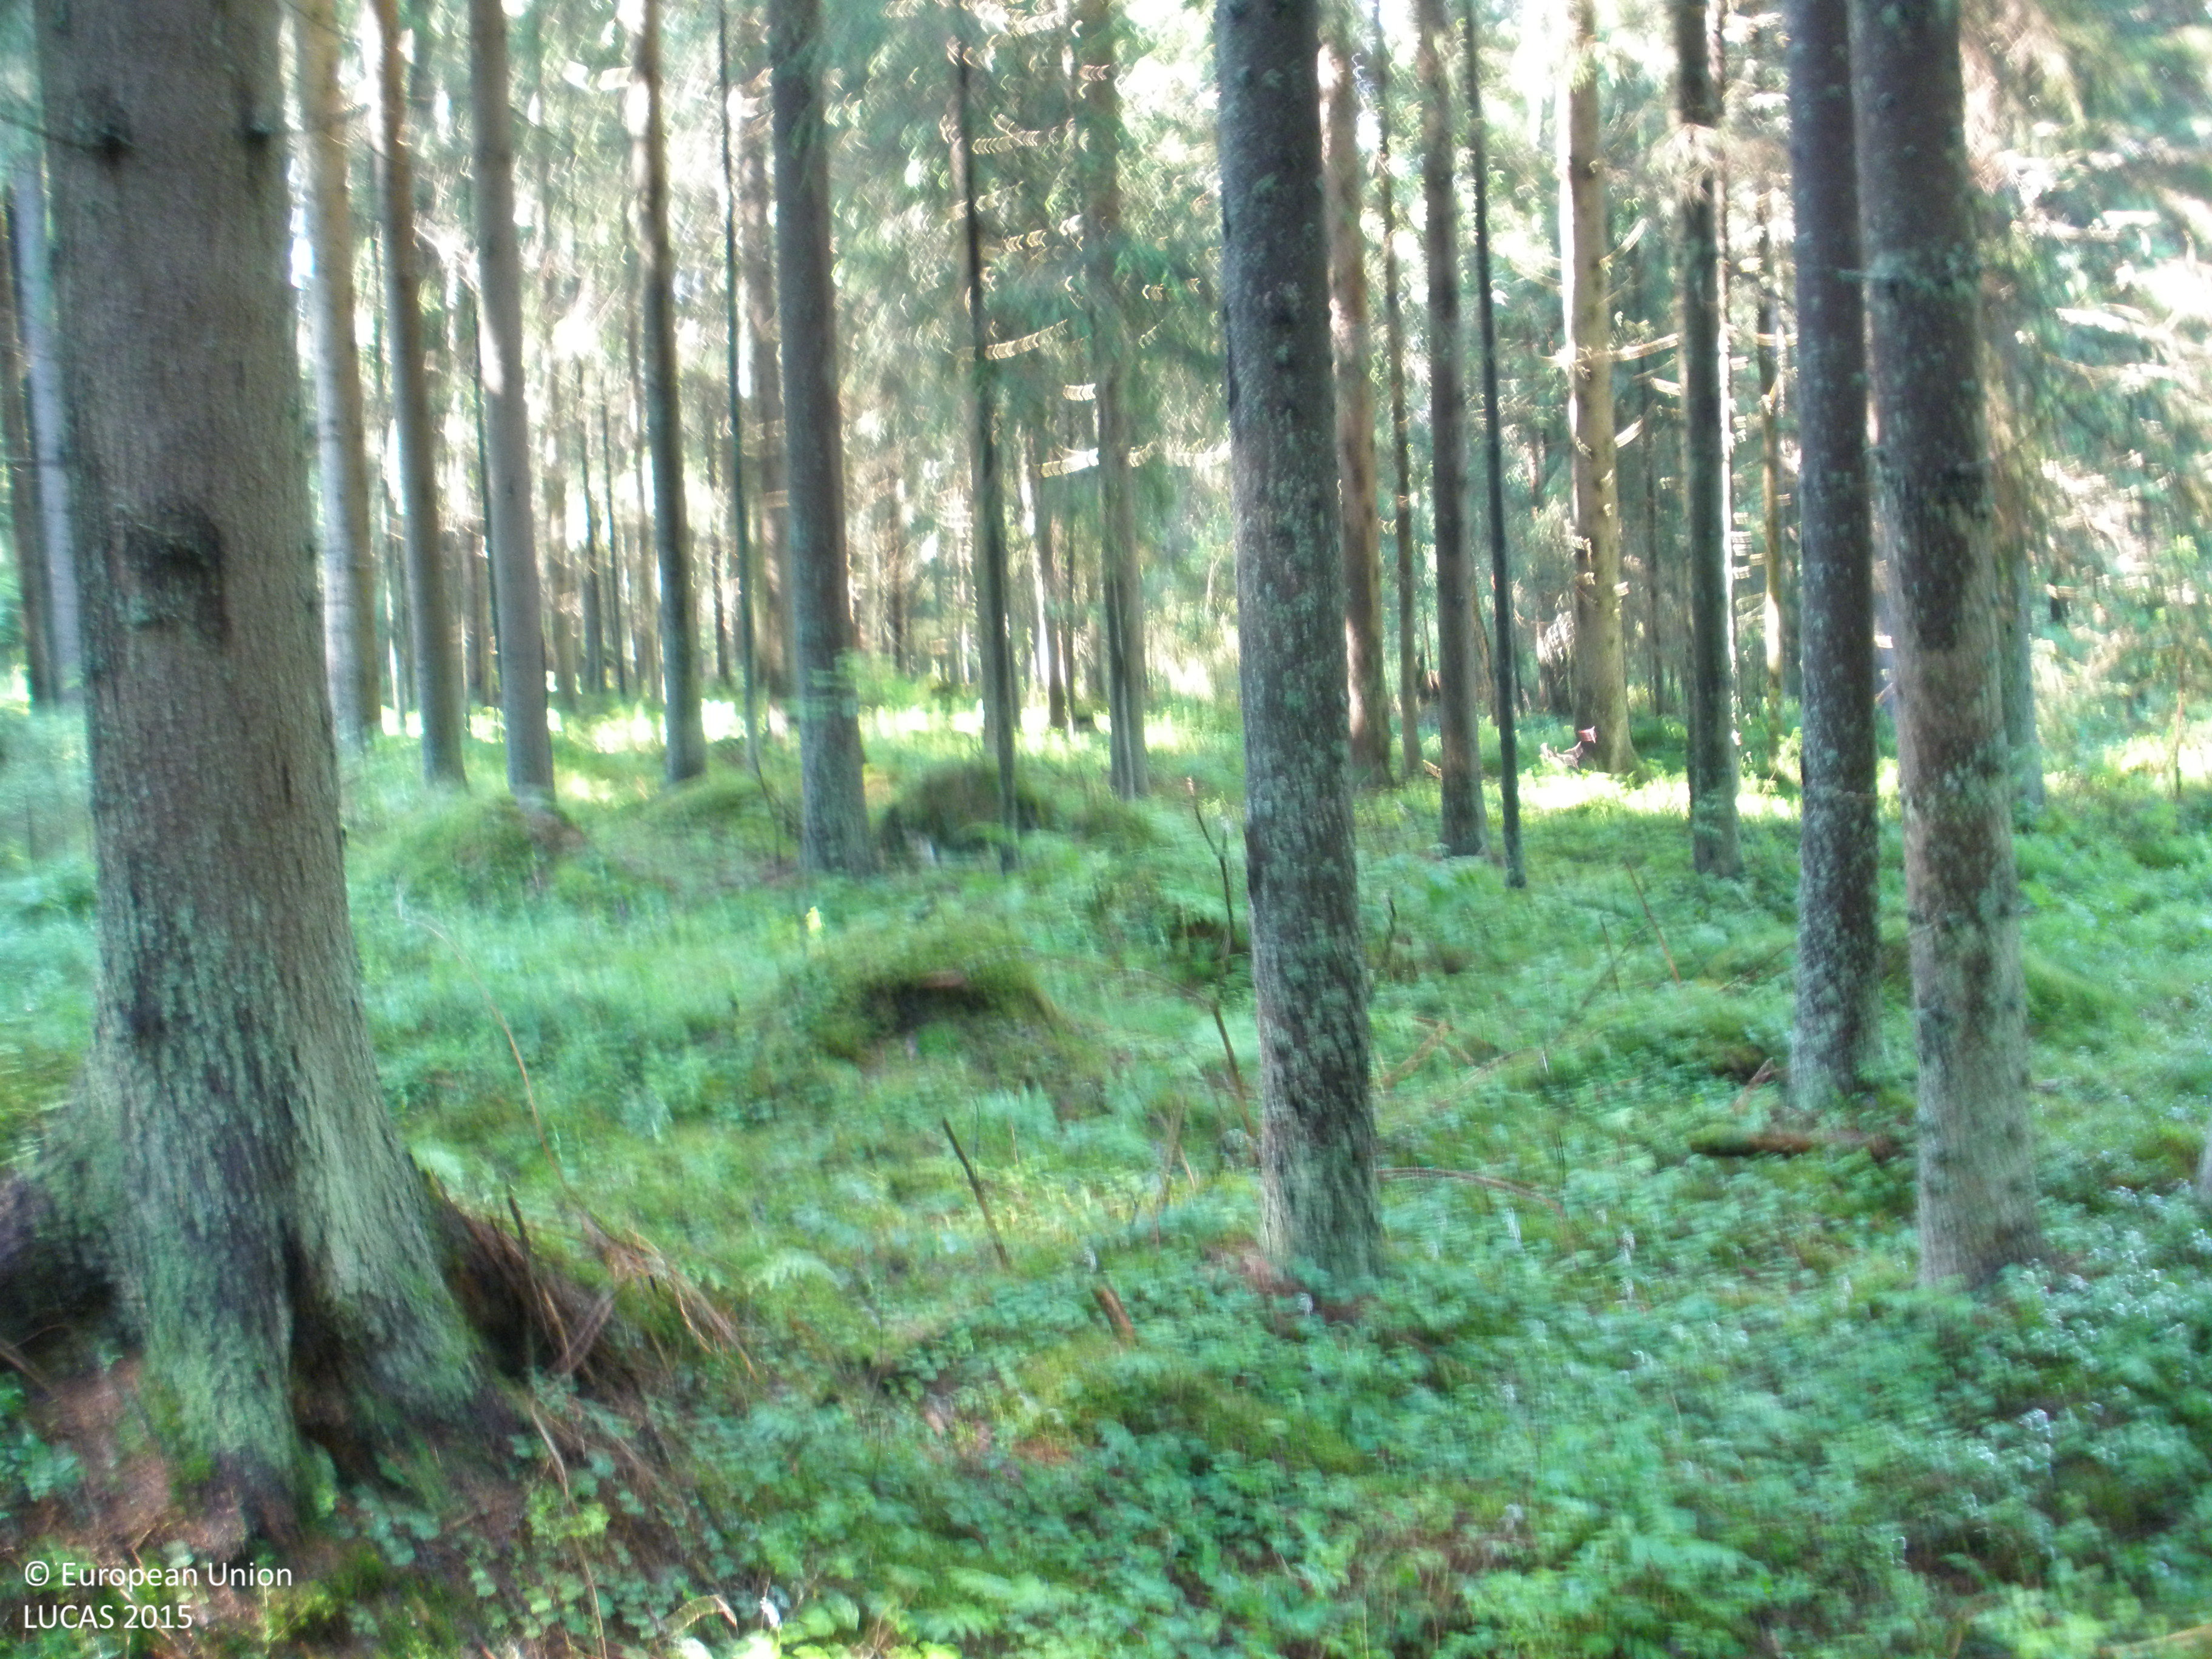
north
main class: Woodland
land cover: Spruce dominated coniferous woodland
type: boreal forest
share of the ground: > 75 %
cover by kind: coniferous forest trees 95 %, lichens and mosses 5 %
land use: Forestry
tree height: > 5 m
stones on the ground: < 10 %
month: June
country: FI
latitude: 60.9904
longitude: 23.5224
